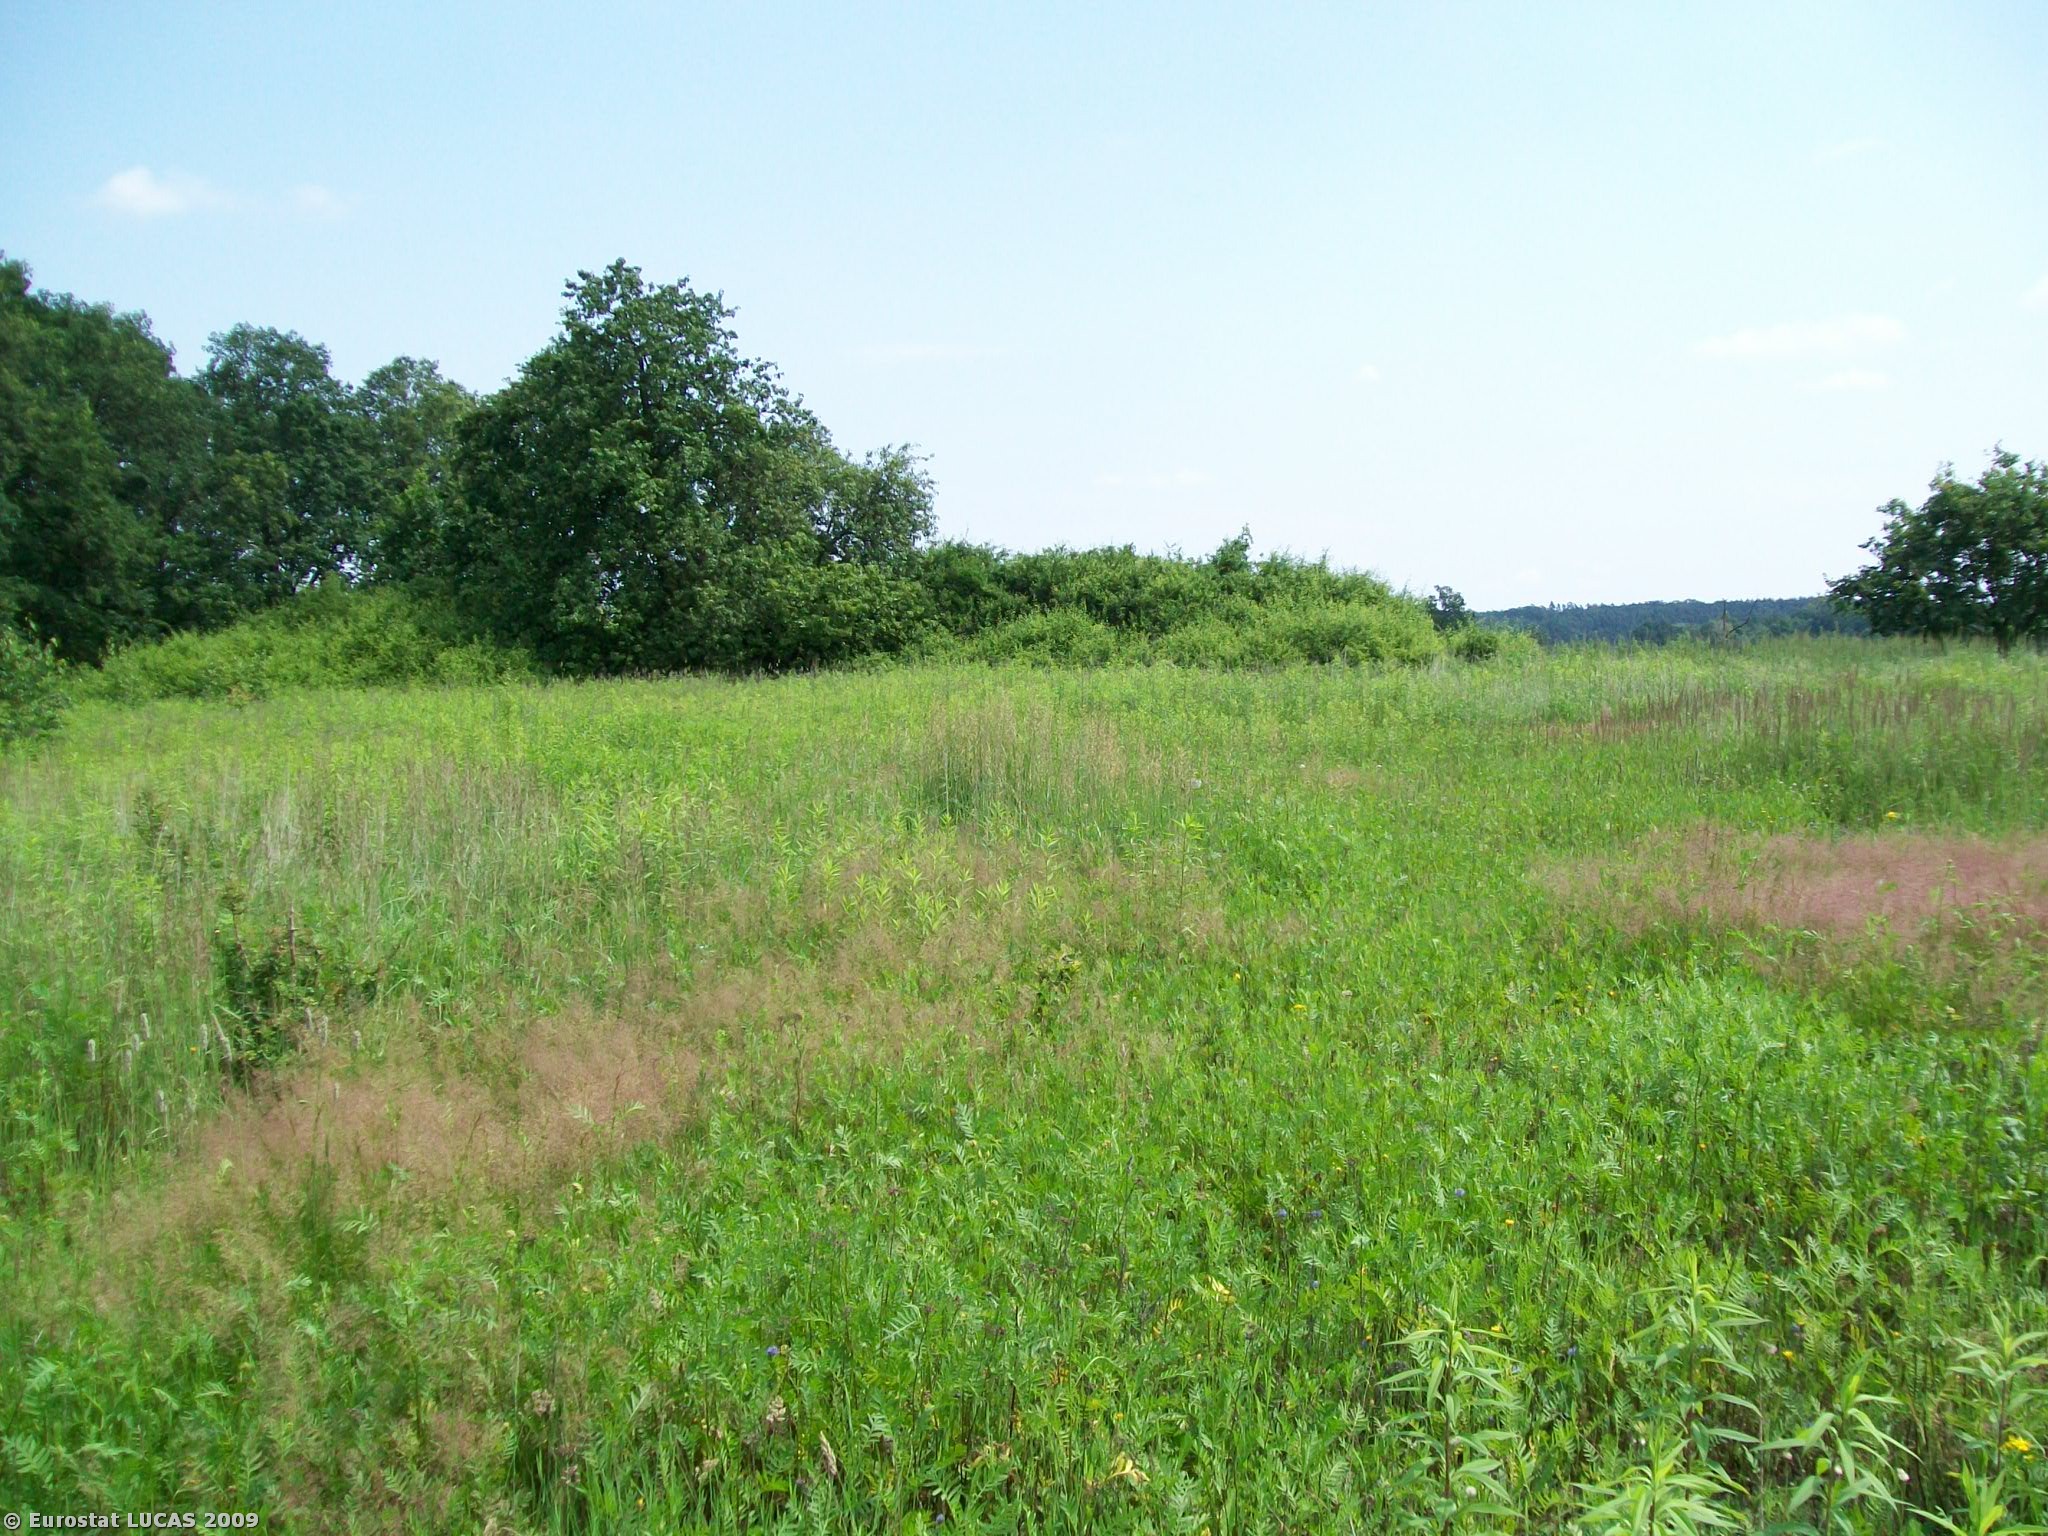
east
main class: Grassland
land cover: Spontaneously vegetated surfaces
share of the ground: > 75 %
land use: Unused
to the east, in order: Spontaneously vegetated surfaces; Shrubland with sparse tree cover; Tracks; Spontaneously vegetated surfaces; Grassland with sparse tree/shrub cover; Spontaneously vegetated surfaces
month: July
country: PL
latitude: 51.2094
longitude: 16.7798
